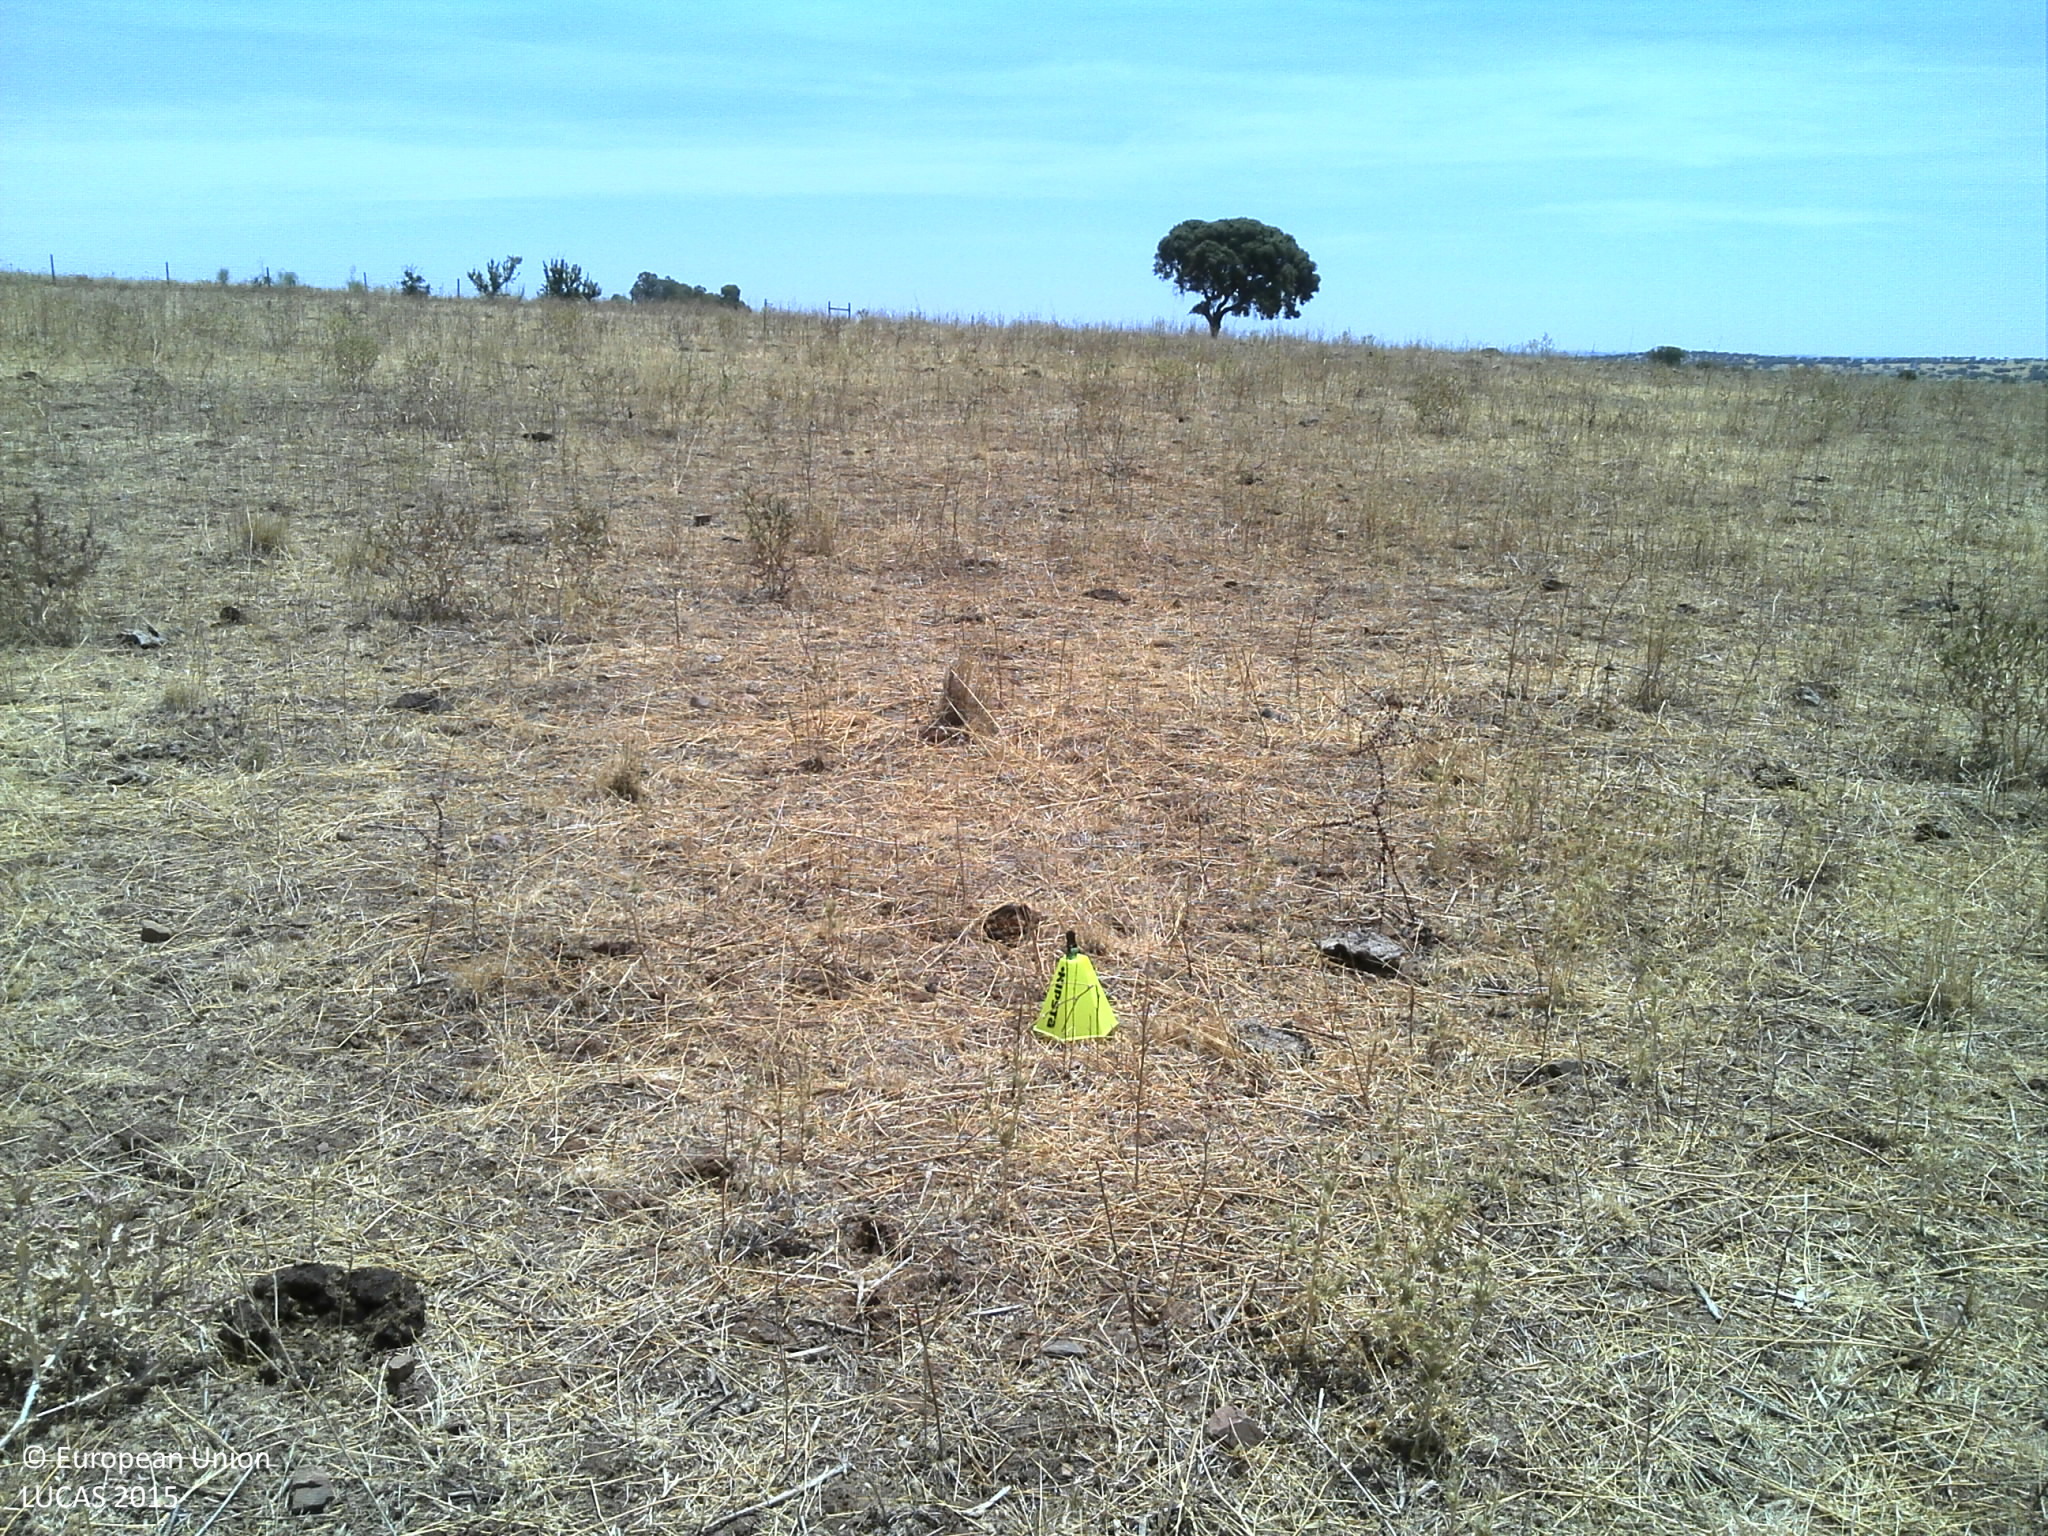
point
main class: Grassland
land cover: Spontaneously vegetated surfaces
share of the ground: 10 - 25 %
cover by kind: unconsolidated bare surface 90 %, herbaceous plants 10 %
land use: Agriculture (excluding fallow land and kitchen gardens)
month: July
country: PT
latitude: 38.3743
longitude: -7.4583
